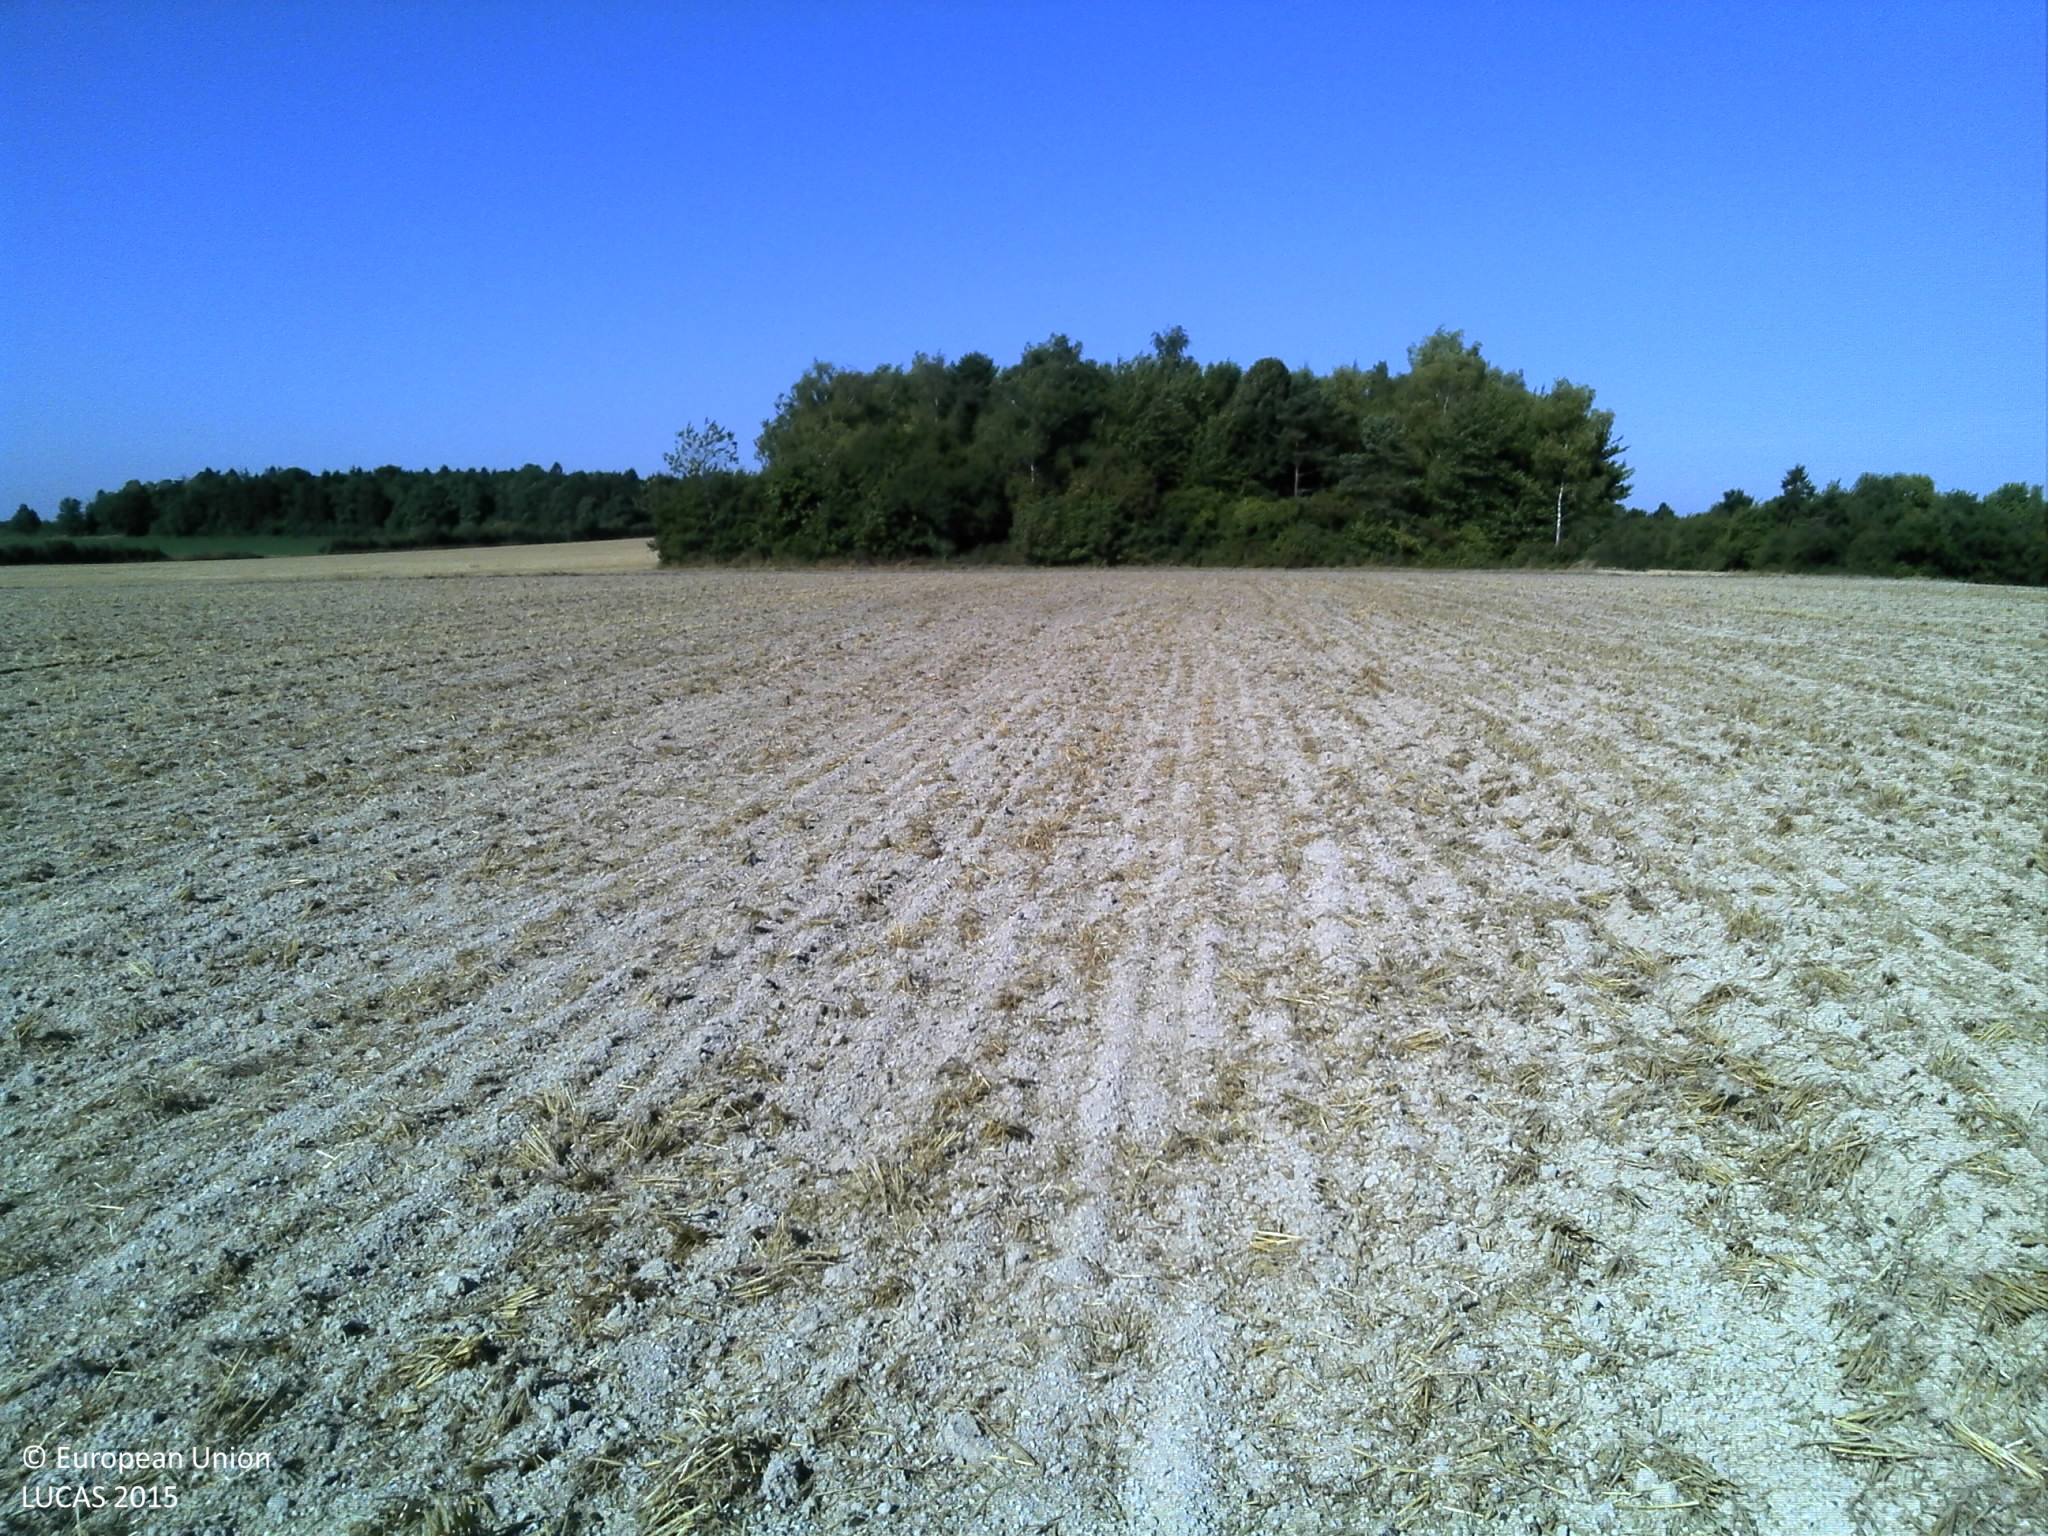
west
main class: Cropland
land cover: Common wheat
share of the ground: > 75 %
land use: Agriculture (excluding fallow land and kitchen gardens)
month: August
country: FR
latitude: 49.0710
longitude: 4.7272
